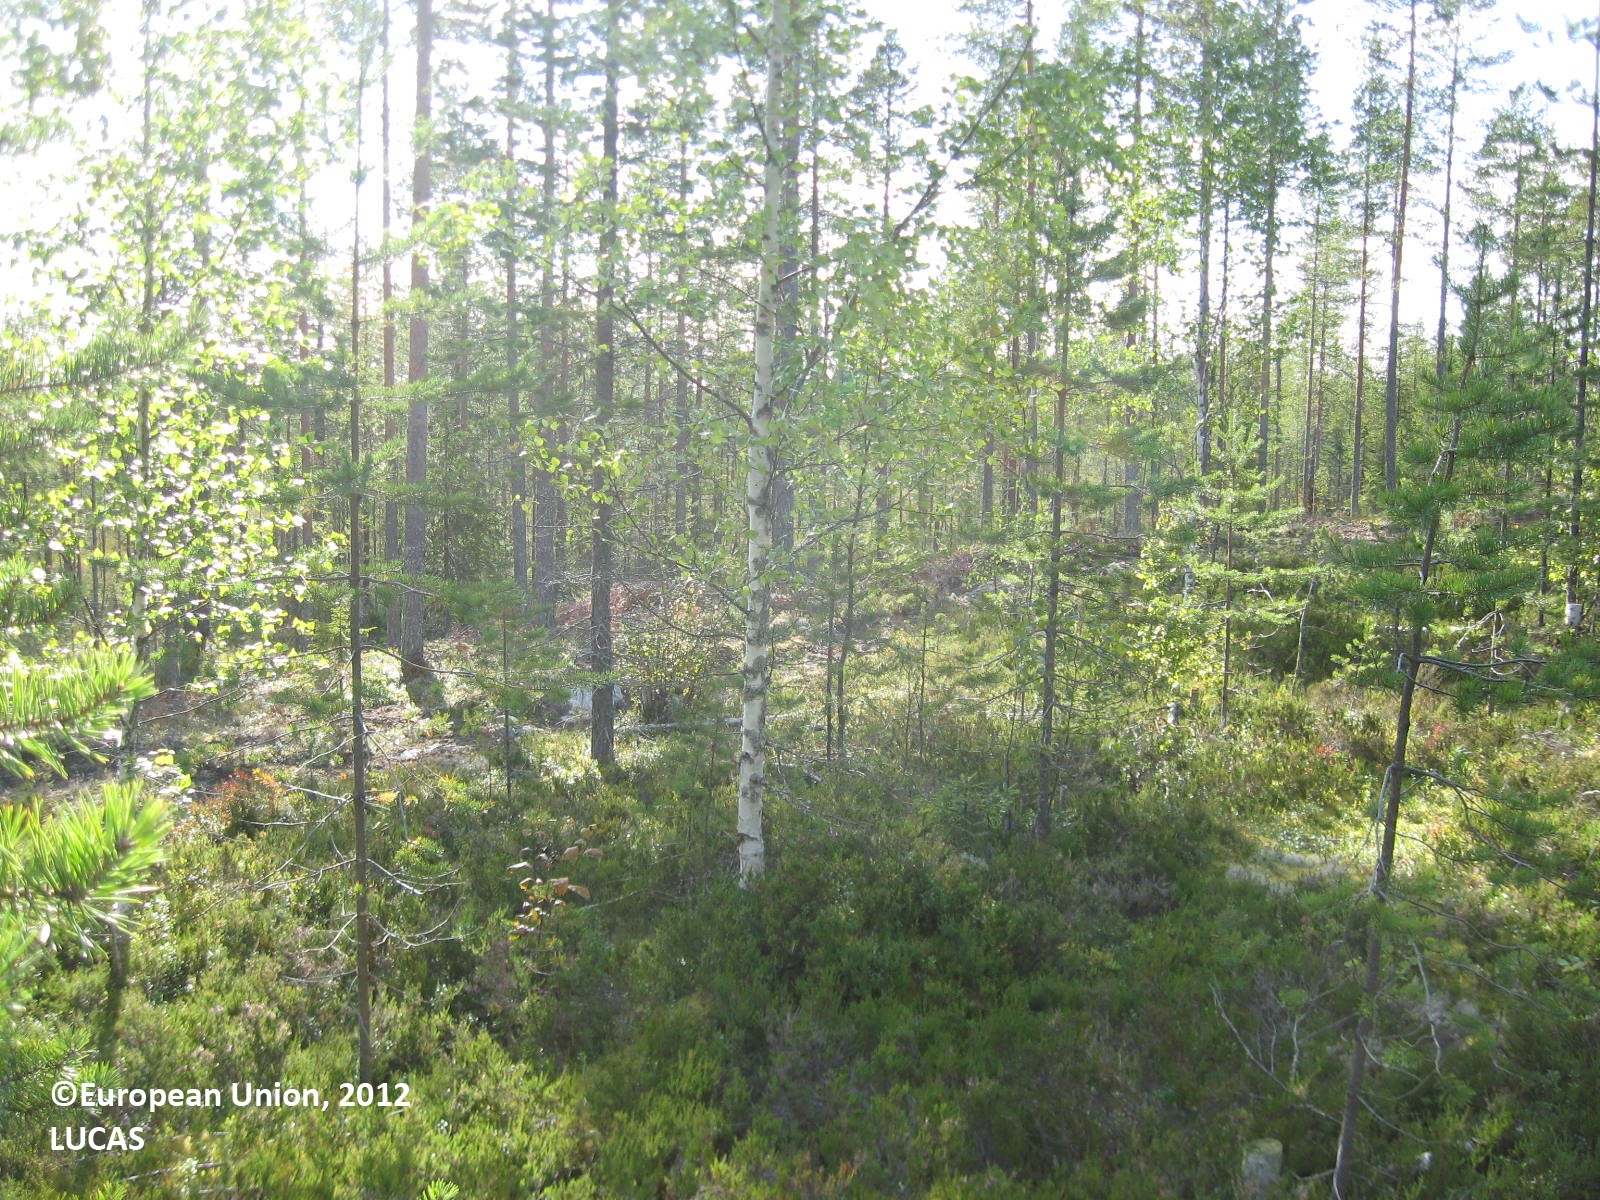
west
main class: Woodland
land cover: Pine dominated mixed woodland
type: boreal forest
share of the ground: > 75 %
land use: Forestry
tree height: > 5 m
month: August
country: FI
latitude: 63.6382
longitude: 29.6287
